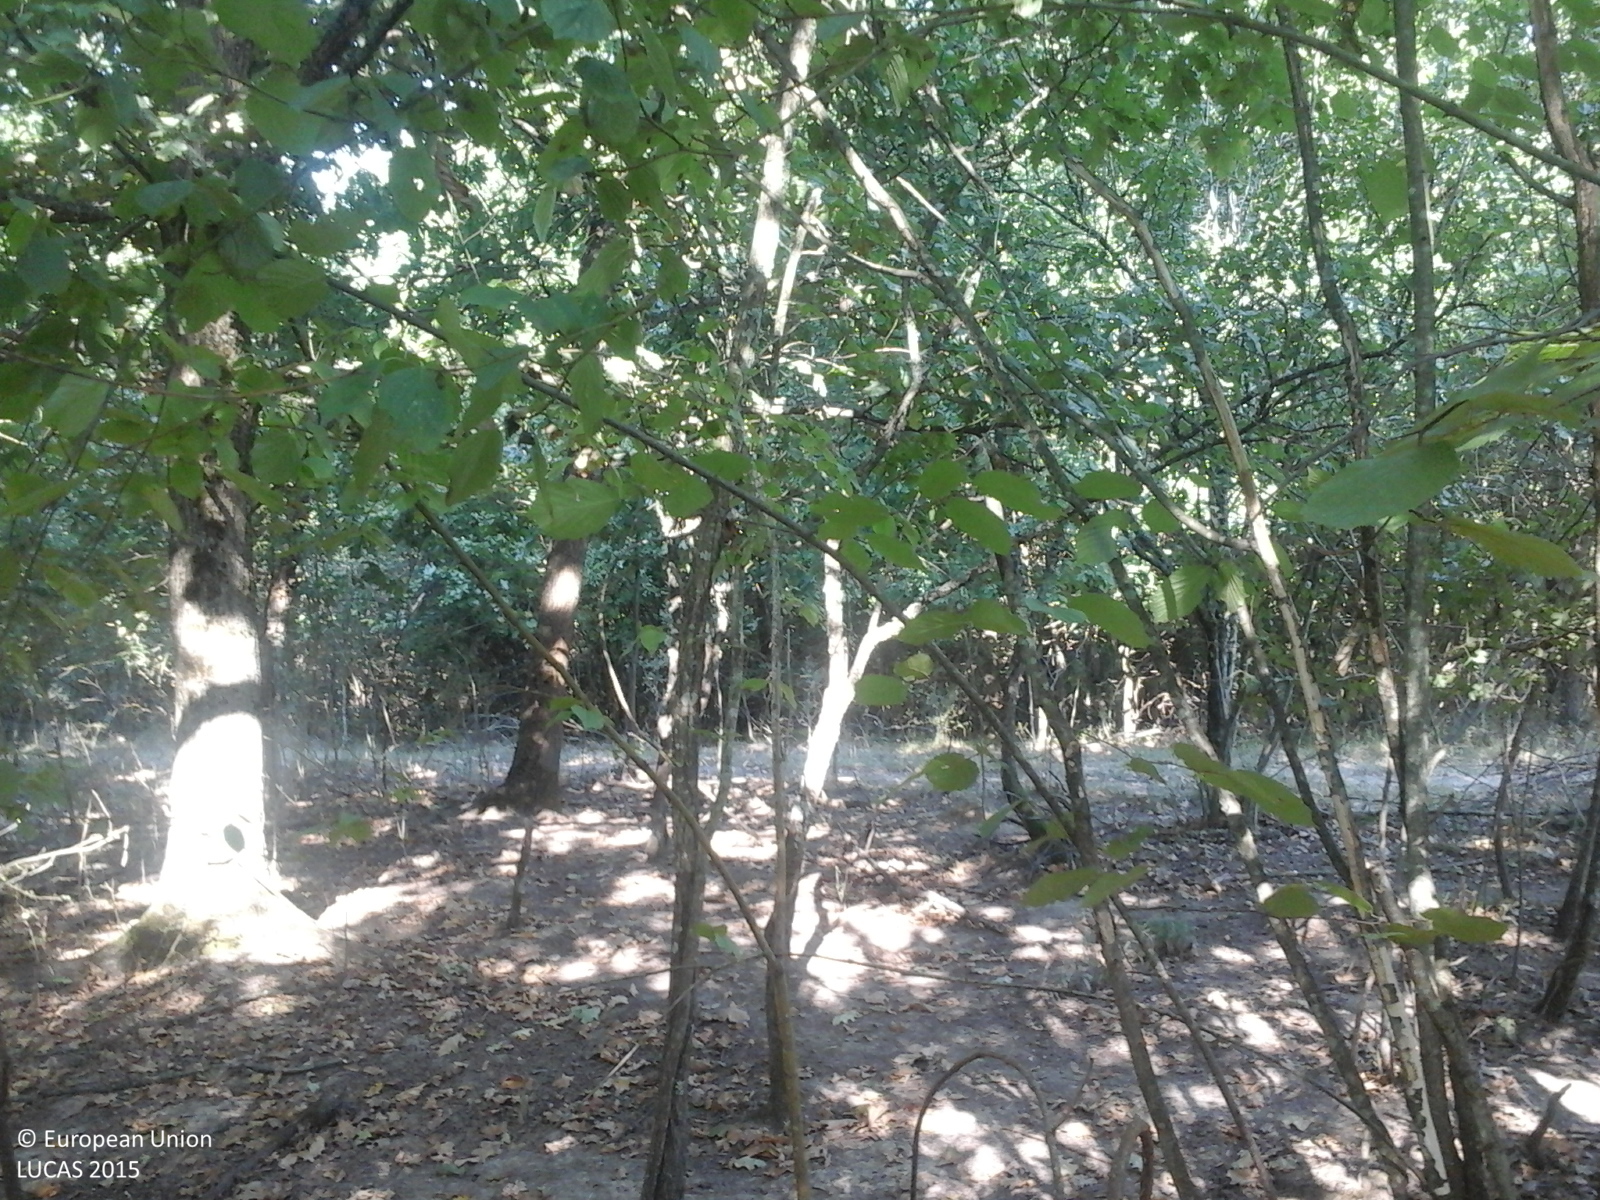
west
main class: Woodland
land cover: Broadleaved woodland
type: acidophilous oak and oak-birch forest
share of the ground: > 75 %
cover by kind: broadleaved forest trees 100 %
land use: Forestry
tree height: > 5 m
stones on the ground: < 10 %
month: August
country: RO
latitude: 46.4133
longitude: 22.2108
